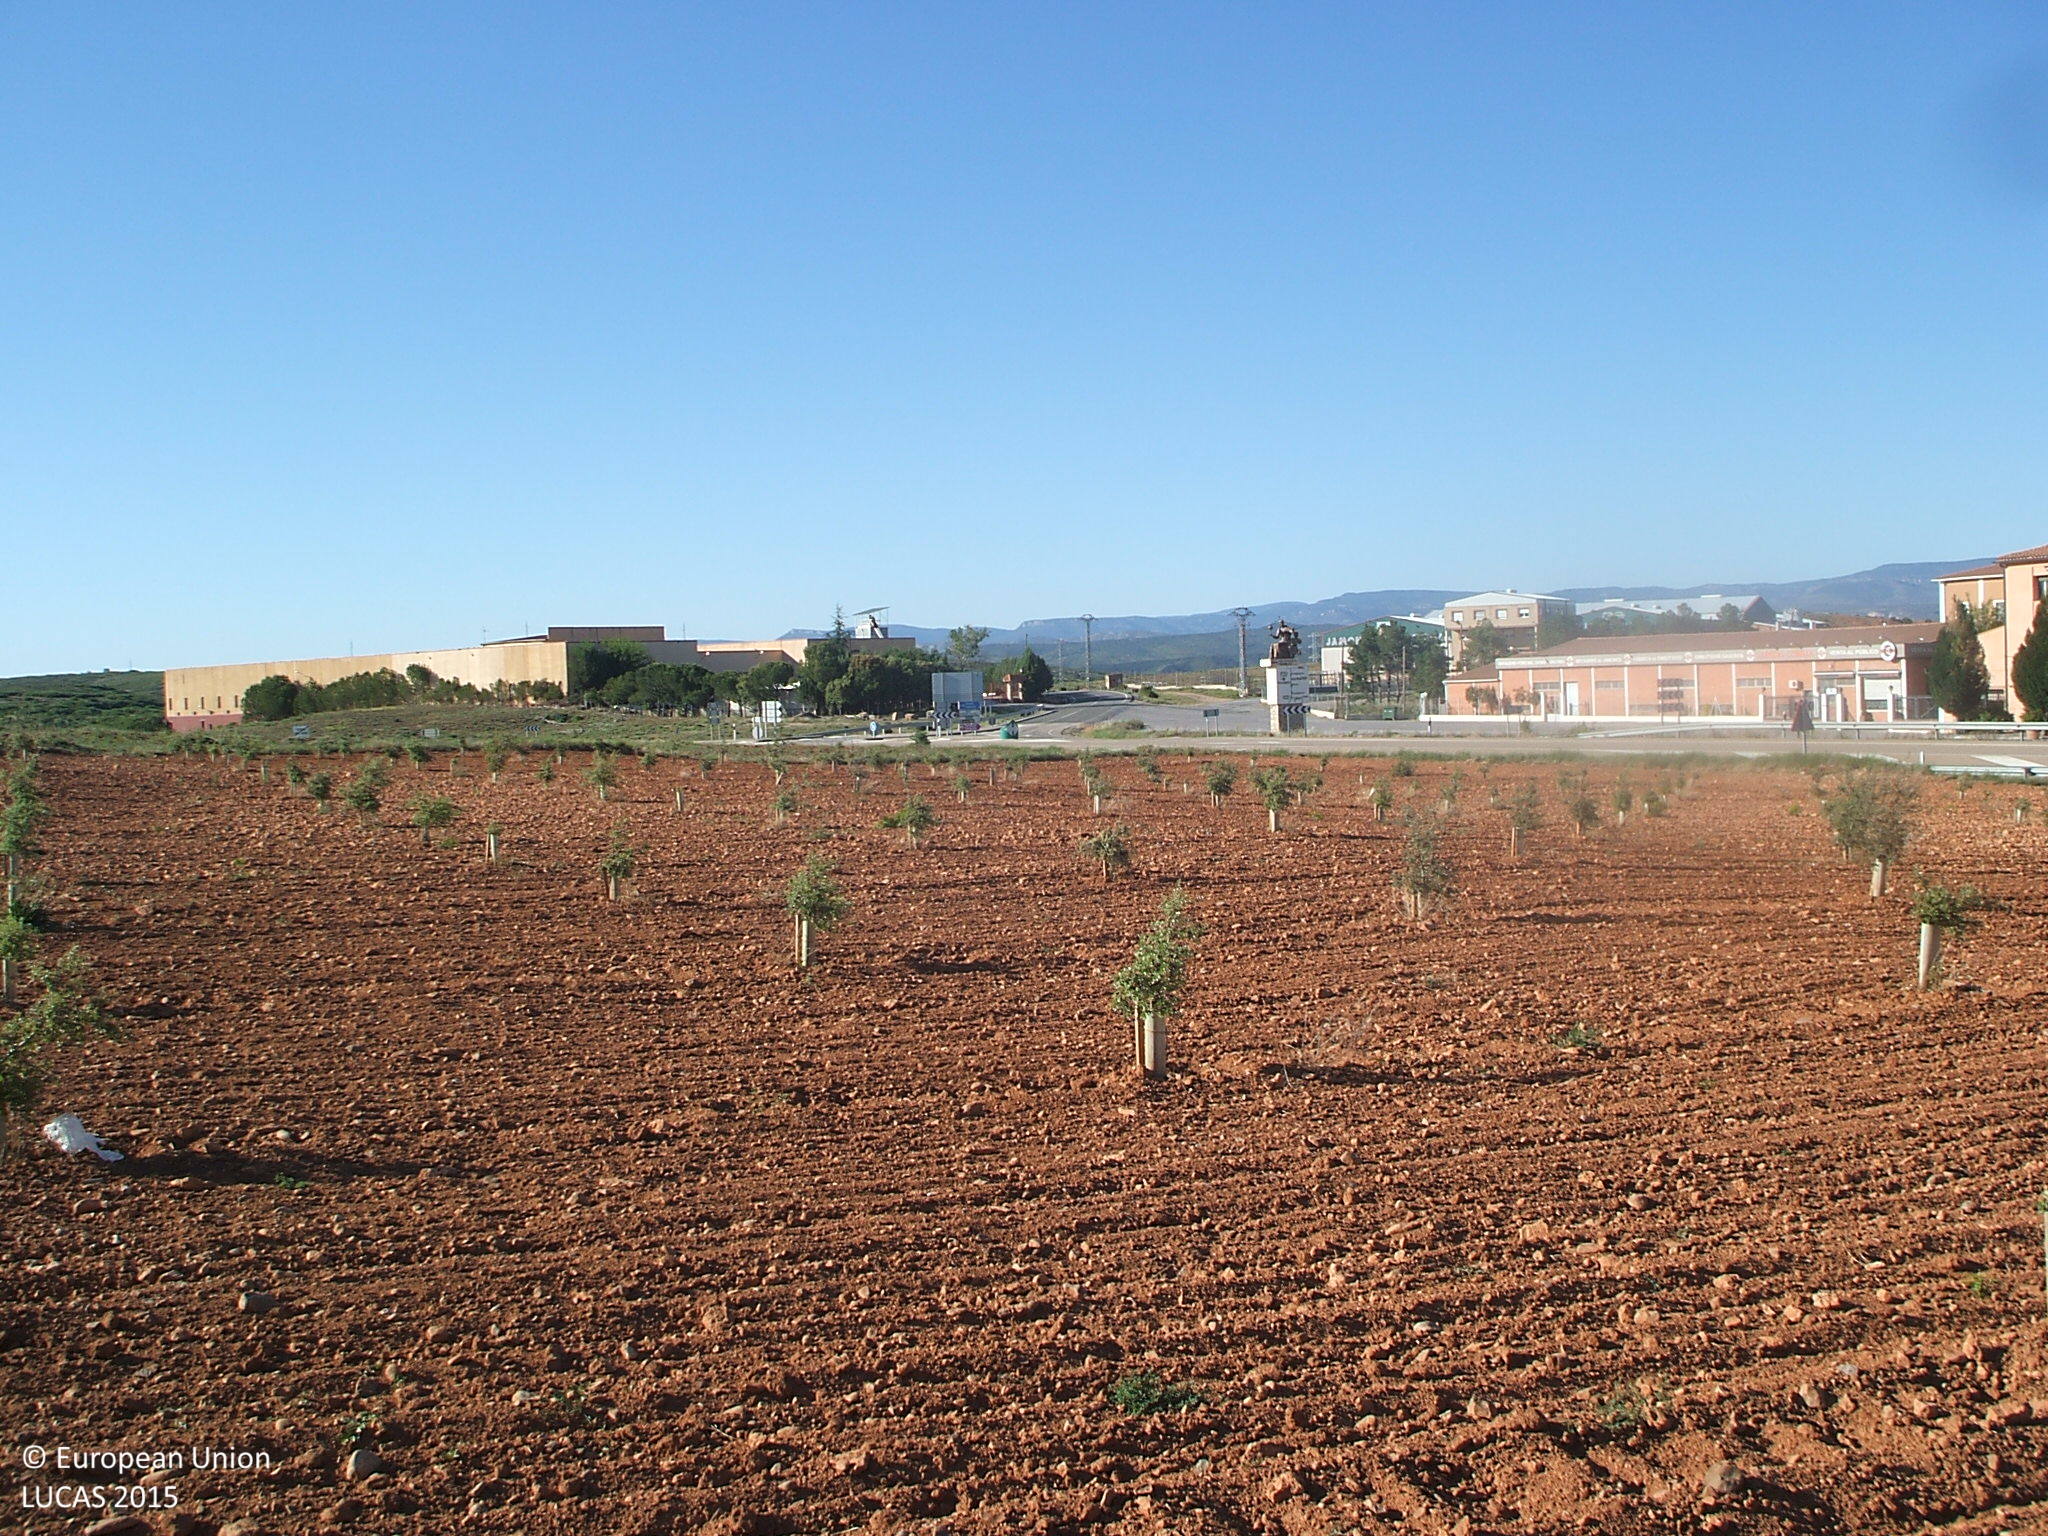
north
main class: Woodland
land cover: Broadleaved woodland
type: broadleaved evergreen forest
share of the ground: 10 - 25 %
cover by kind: unconsolidated bare surface 85 %, broadleaved forest trees 15 %
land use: Forestry
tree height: < 5 m
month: May
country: ES
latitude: 40.1136
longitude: -0.7413
